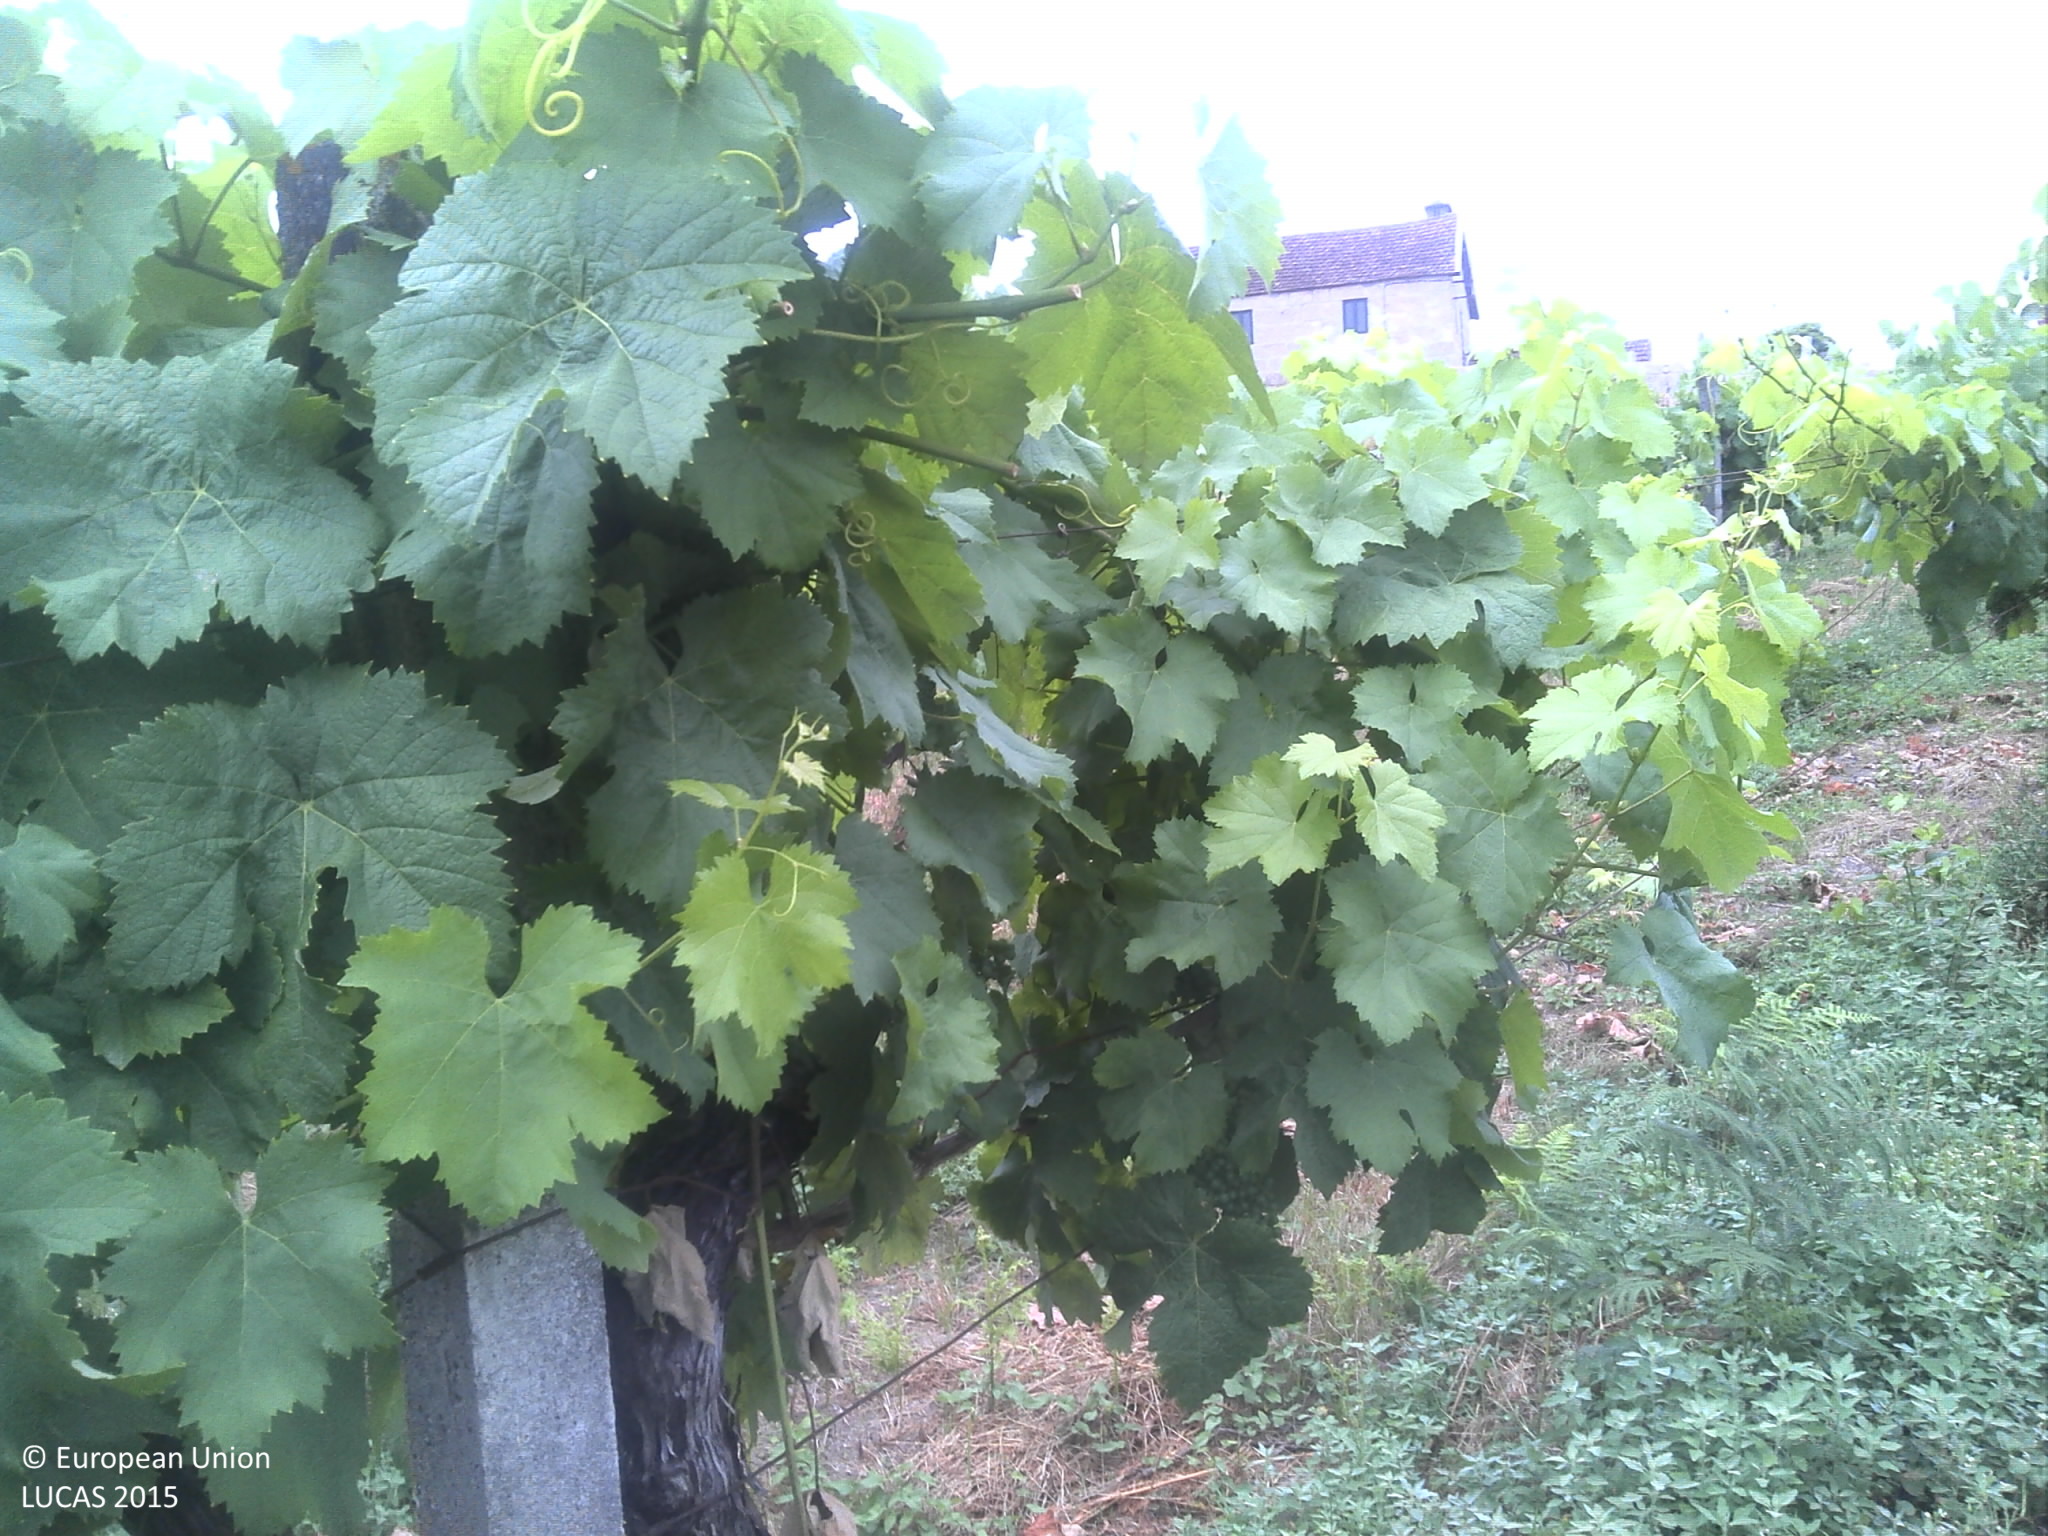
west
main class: Cropland
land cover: Vineyards
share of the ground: 25 - 50 %
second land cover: Grassland without tree/shrub cover
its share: 50 - 75 %
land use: Agriculture (excluding fallow land and kitchen gardens)
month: June
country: PT
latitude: 41.2345
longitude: -8.1687
